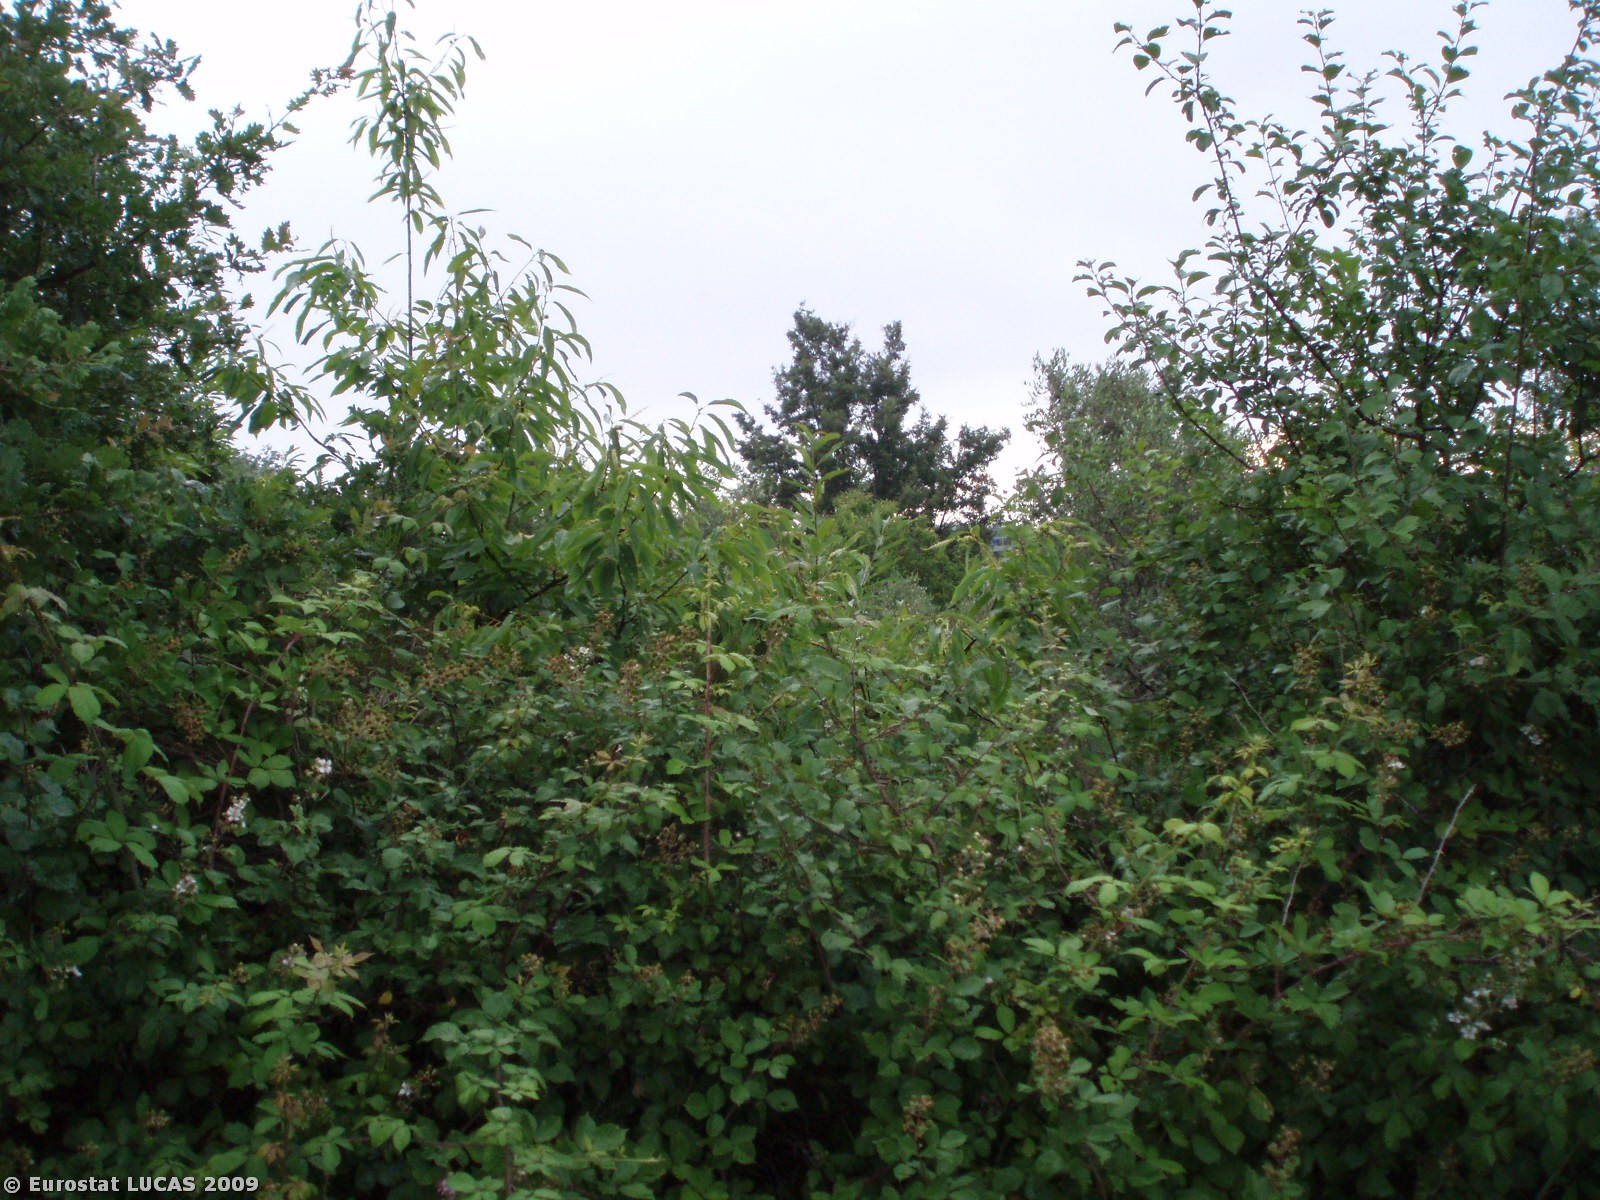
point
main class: Shrubland
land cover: Shrubland with sparse tree cover
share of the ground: > 75 %
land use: Fallow land
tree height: > 5 m
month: June
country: IT
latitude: 42.6776
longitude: 11.5934
